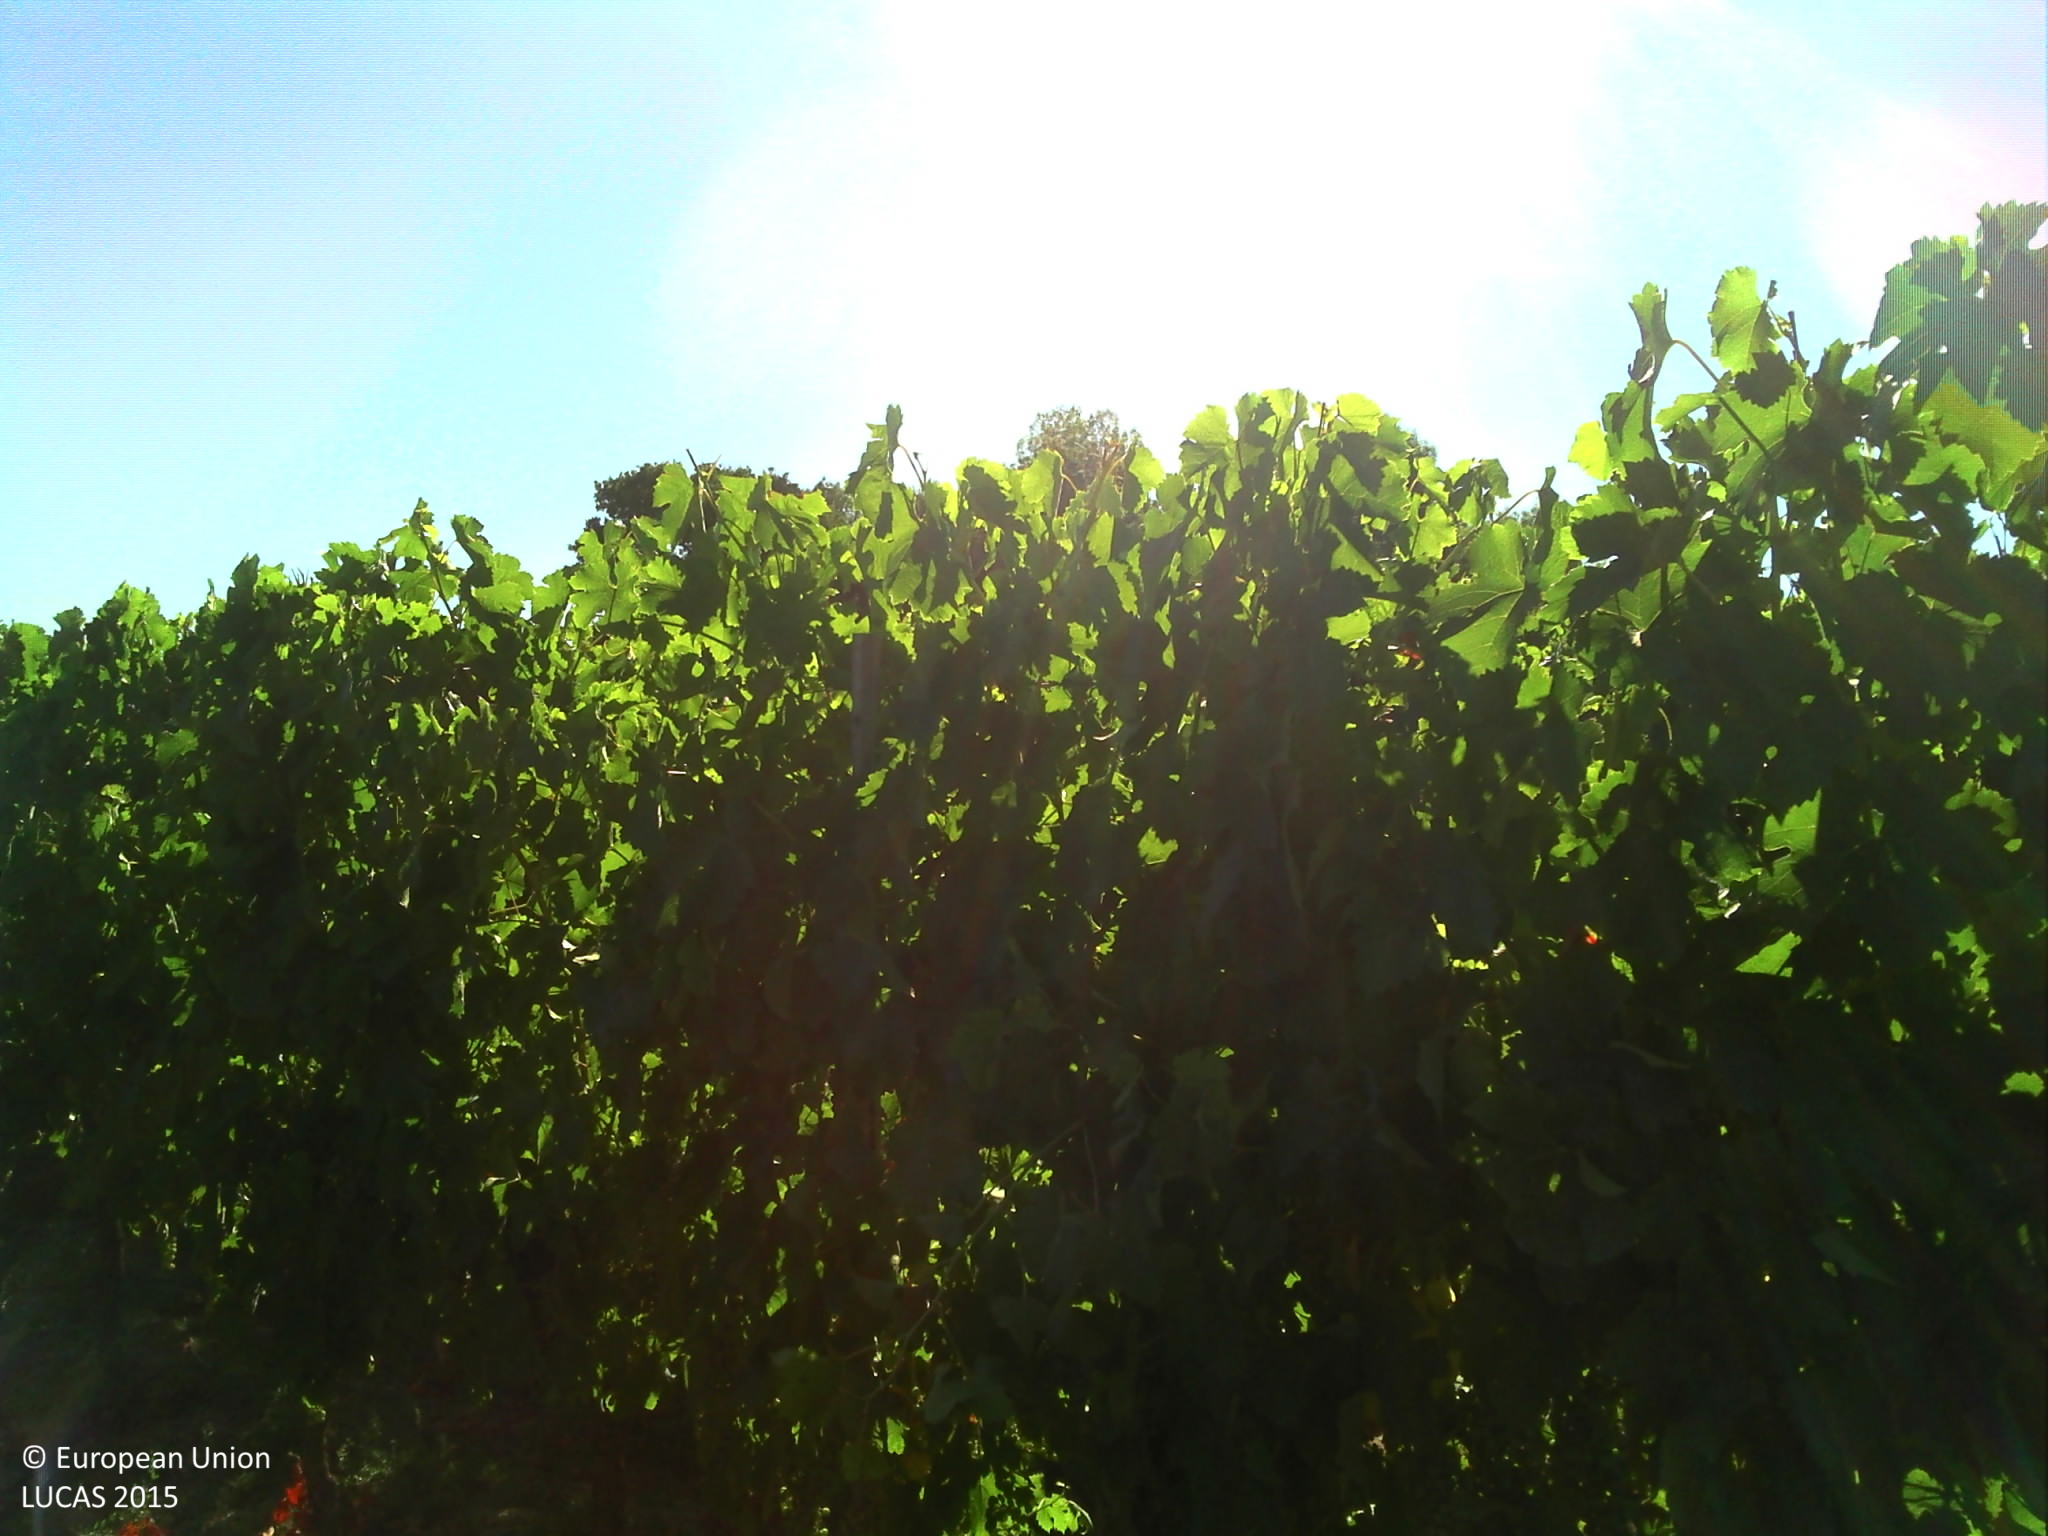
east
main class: Cropland
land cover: Vineyards
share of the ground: 10 - 25 %
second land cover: Grassland without tree/shrub cover
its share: 10 - 25 %
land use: Agriculture (excluding fallow land and kitchen gardens)
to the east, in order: Vineyards; Grassland without tree/shrub cover; Temporary grasslands; Electric lines; Temporary grasslands; Managed hedges; Other mixed woodland; Tracks; Other mixed woodland; Electric lines; Other mixed woodland; Grass margins; Paved roads, cycling and walking lanes; Electric lines; Ditches and canals; Maize; Ditches and canals; Grass margins; Paved roads, cycling and walking lanes; Grass margins; Ditches and canals; Electric lines; Common wheat
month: July
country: FR
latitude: 44.5347
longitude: 0.5414
